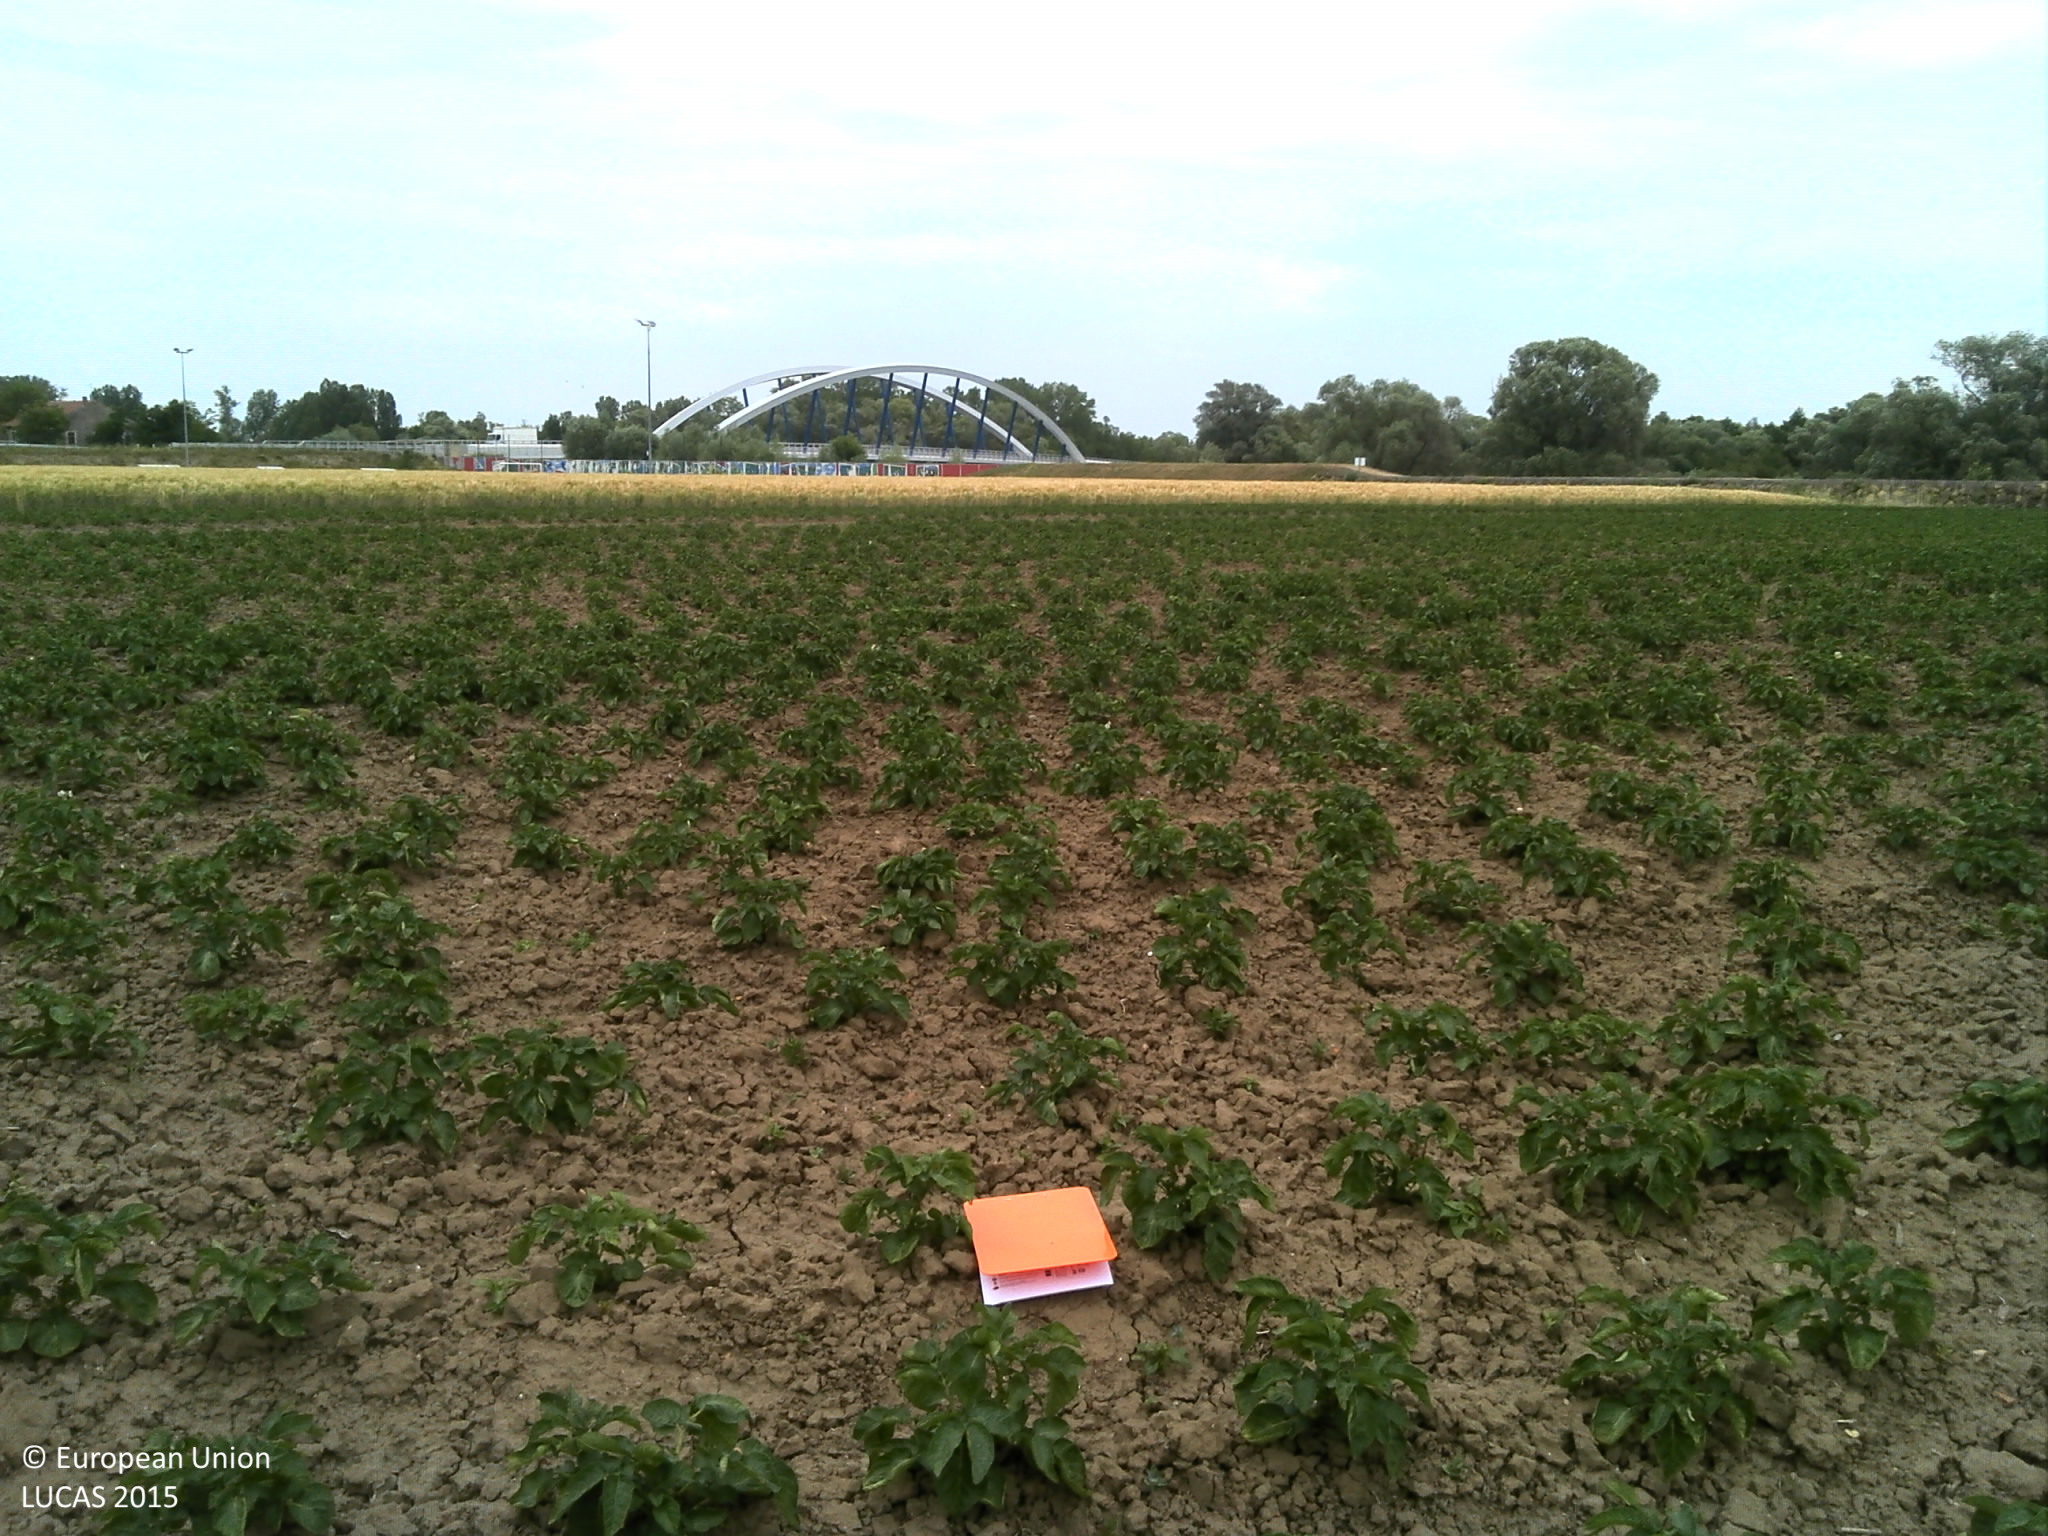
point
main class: Cropland
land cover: Potatoes
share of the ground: 25 - 50 %
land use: Agriculture (excluding fallow land and kitchen gardens)
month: June
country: FR
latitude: 49.2206
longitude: 6.1965
